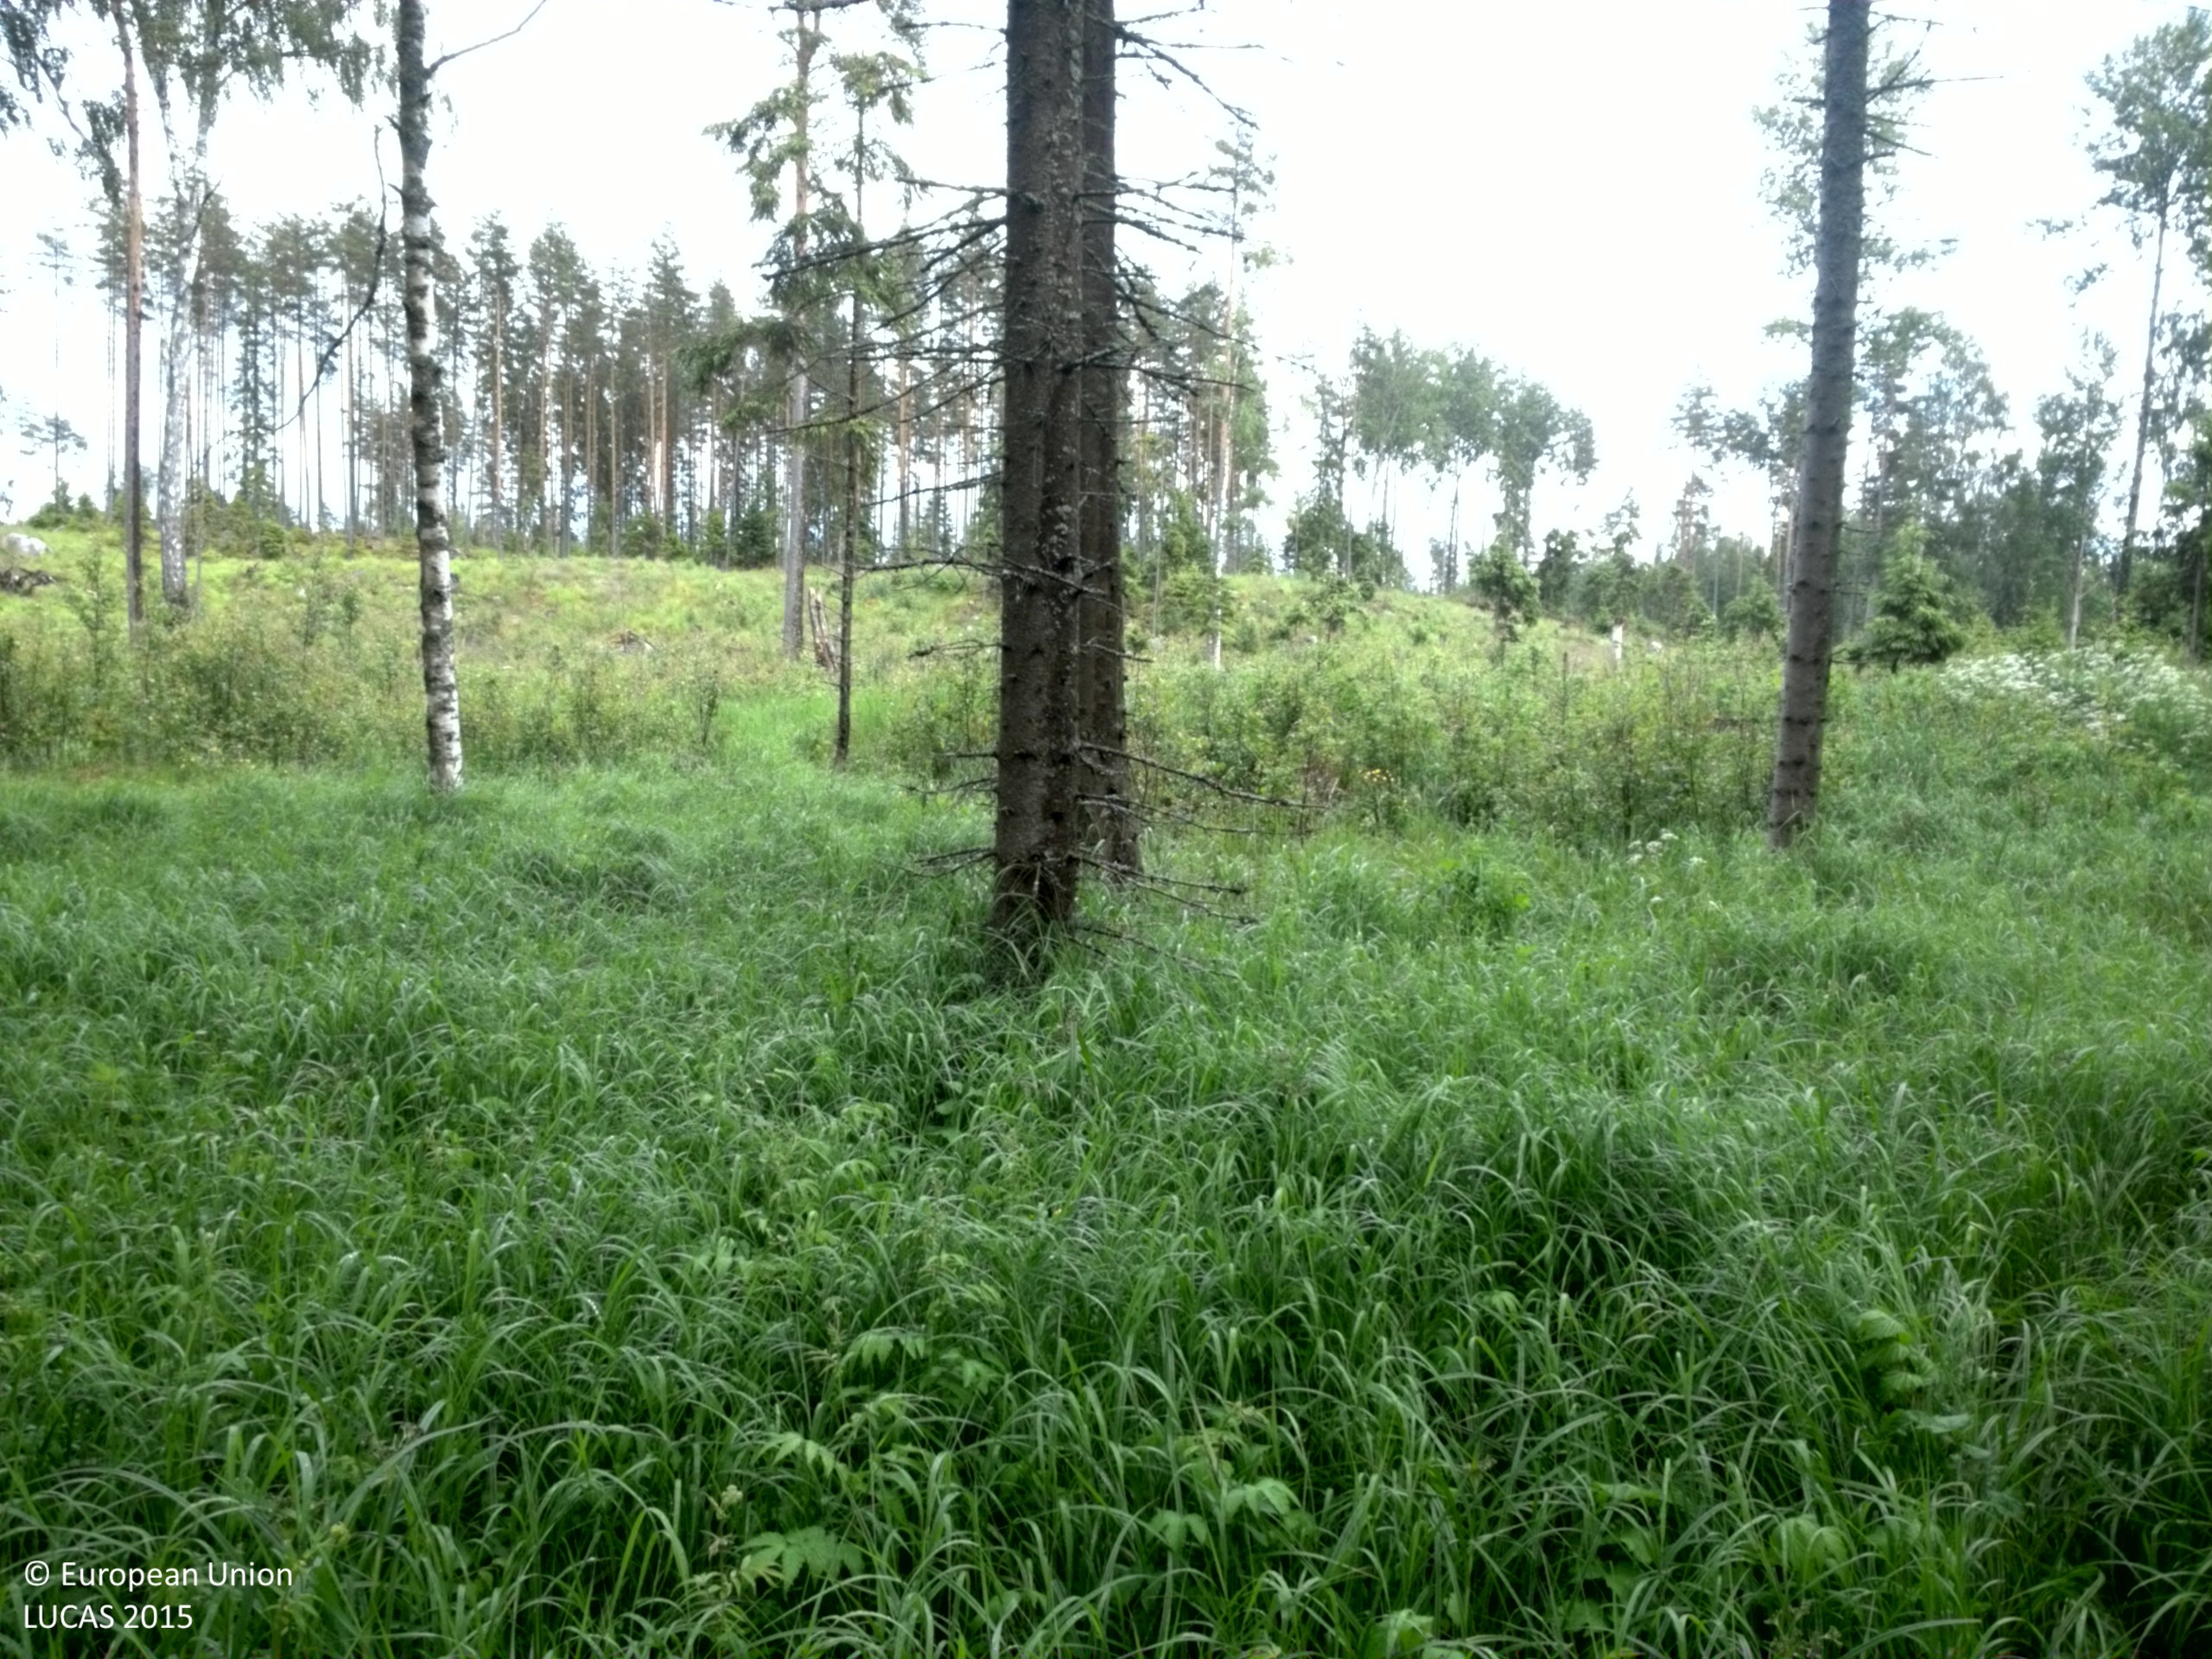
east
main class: Woodland
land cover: Spruce dominated coniferous woodland
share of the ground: 25 - 50 %
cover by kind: herbaceous plants 50 %, coniferous forest trees 40 %, lichens and mosses 5 %, consolidated bare surface 5 %
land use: Forestry
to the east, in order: Spruce dominated coniferous woodland; Grassland with sparse tree/shrub cover; Pine dominated coniferous woodland; Grassland without tree/shrub cover; Broadleaved woodland; Grassland with sparse tree/shrub cover
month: June
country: SE
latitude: 60.3307
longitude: 17.7260
